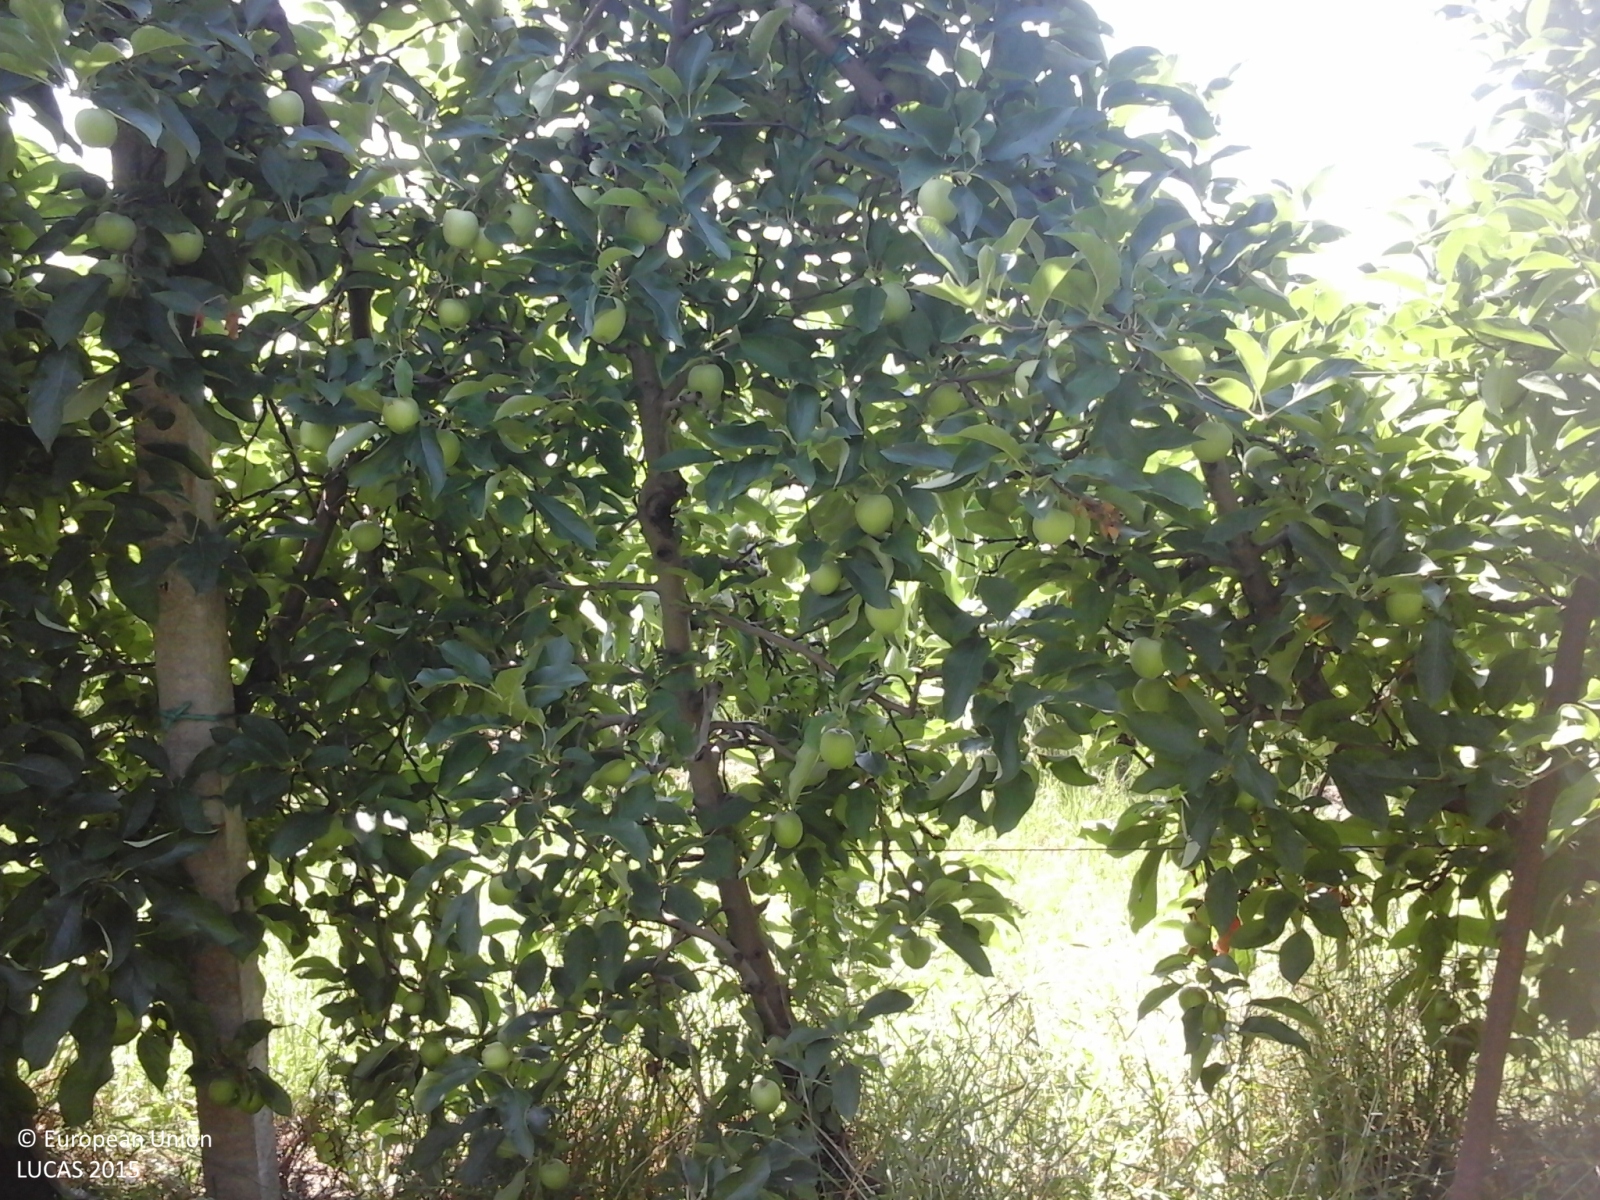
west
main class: Cropland
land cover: Apple fruit
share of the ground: > 75 %
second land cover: Grassland without tree/shrub cover
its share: > 75 %
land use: Agriculture (excluding fallow land and kitchen gardens)
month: June
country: IT
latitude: 45.3355
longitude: 11.1846
